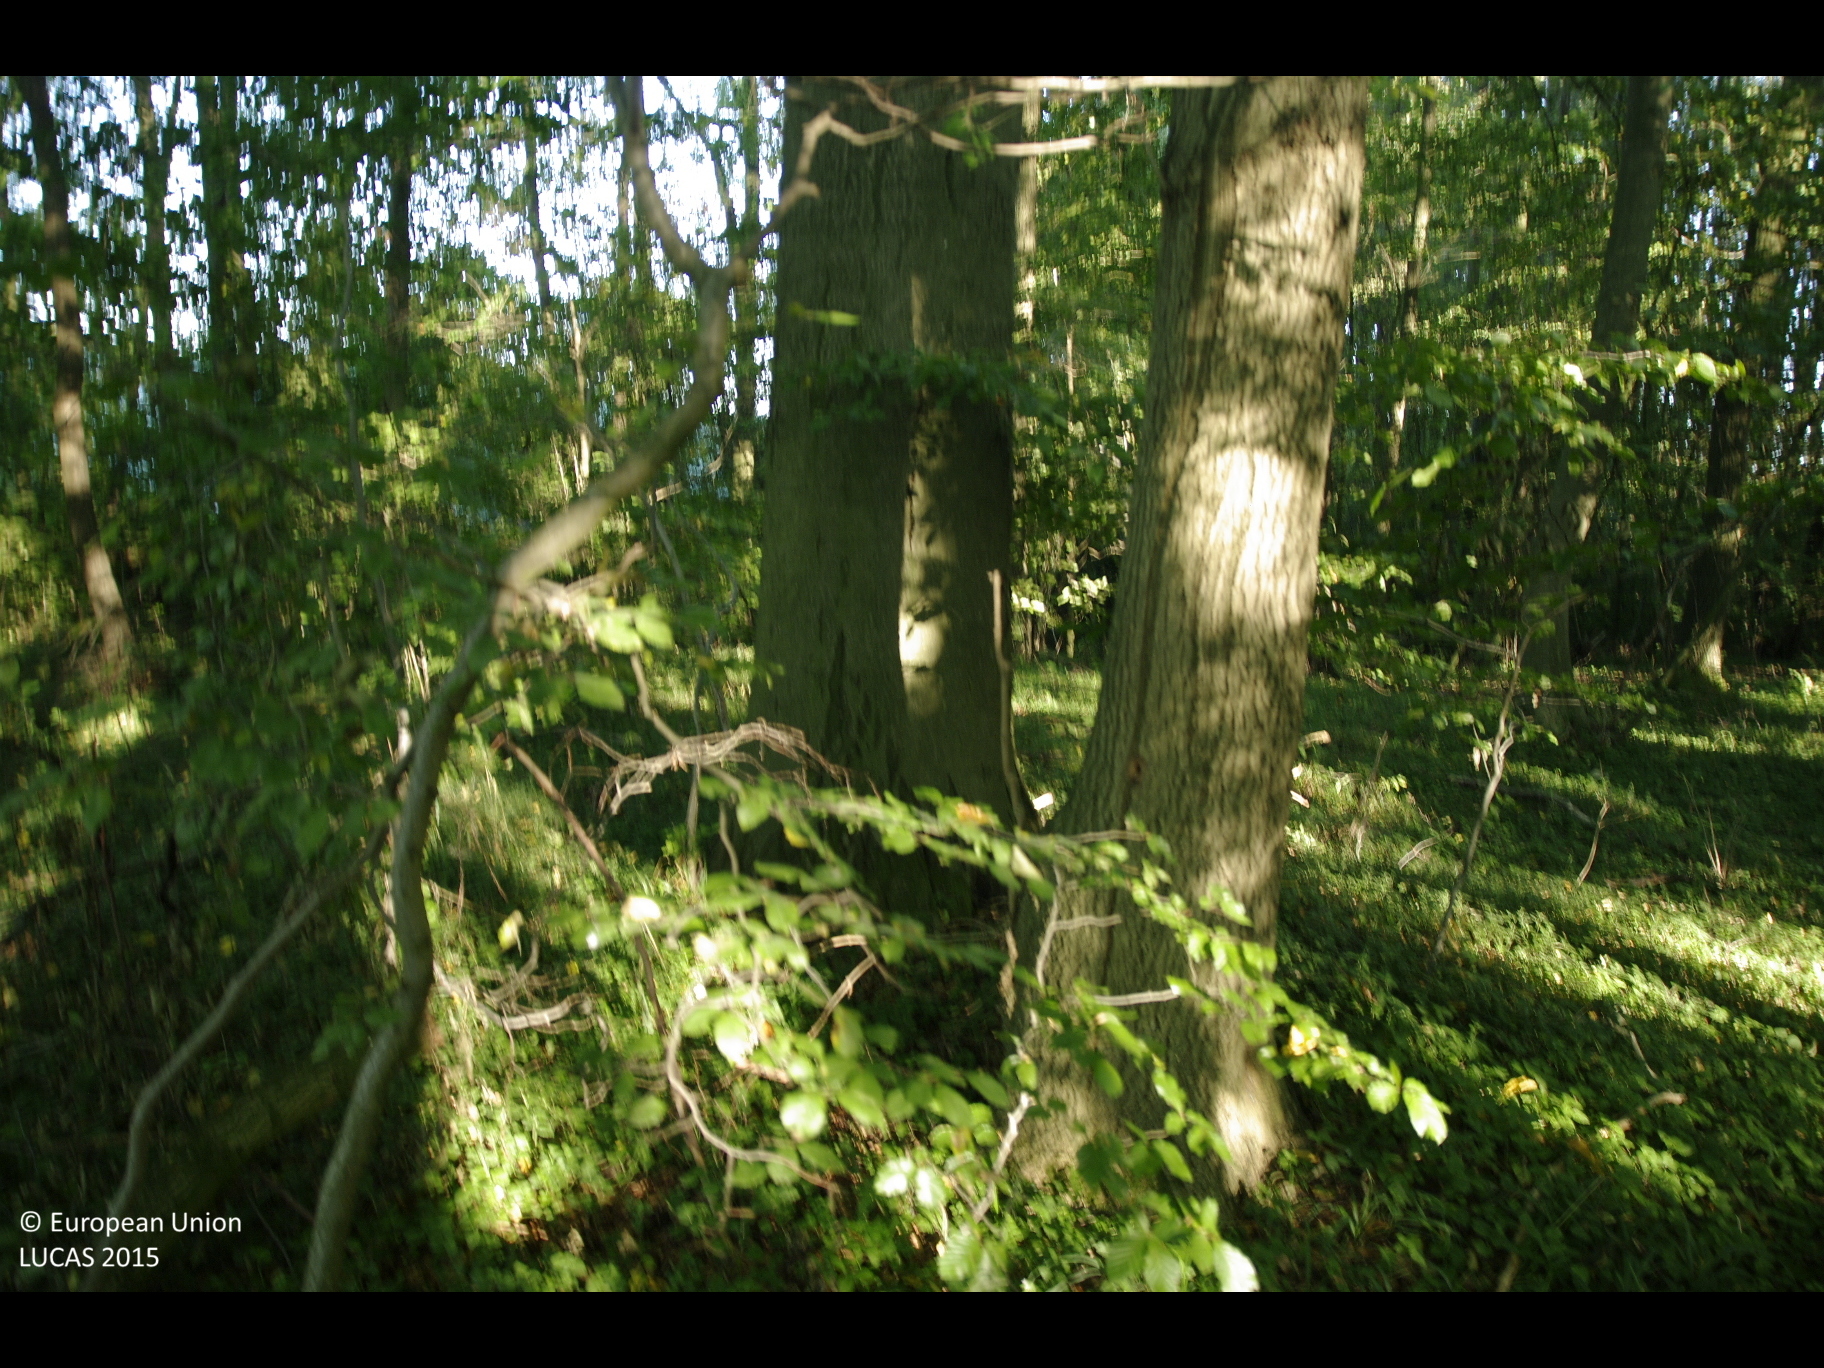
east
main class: Woodland
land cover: Broadleaved woodland
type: mesophytic deciduous forest
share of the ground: > 75 %
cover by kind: broadleaved forest trees 90 %, herbaceous plants 10 %
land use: Semi-natural and natural areas not in use
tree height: > 5 m
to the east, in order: Broadleaved woodland; Grassland without tree/shrub cover; Fences; Grassland without tree/shrub cover
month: October
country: DE
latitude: 53.5082
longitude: 10.6179
